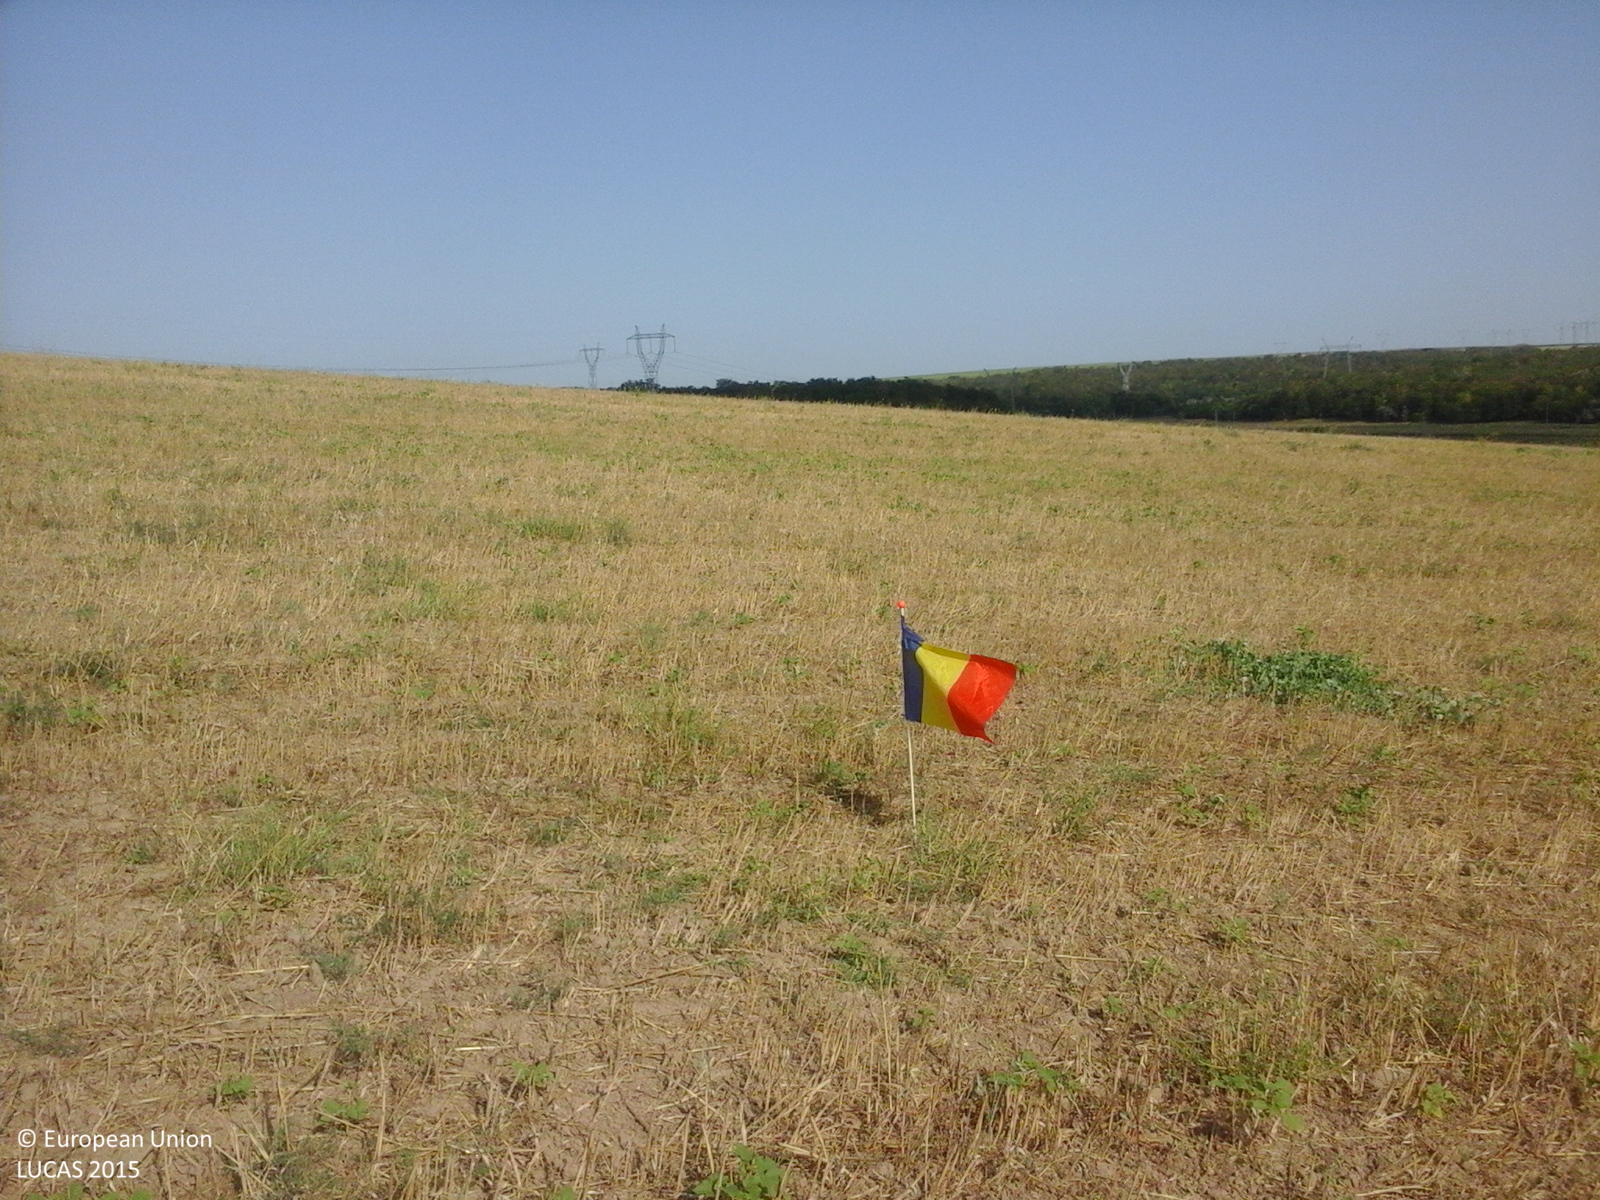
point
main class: Cropland
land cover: Oats
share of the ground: 25 - 50 %
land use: Agriculture (excluding fallow land and kitchen gardens)
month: August
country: RO
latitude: 44.5941
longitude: 28.0616
